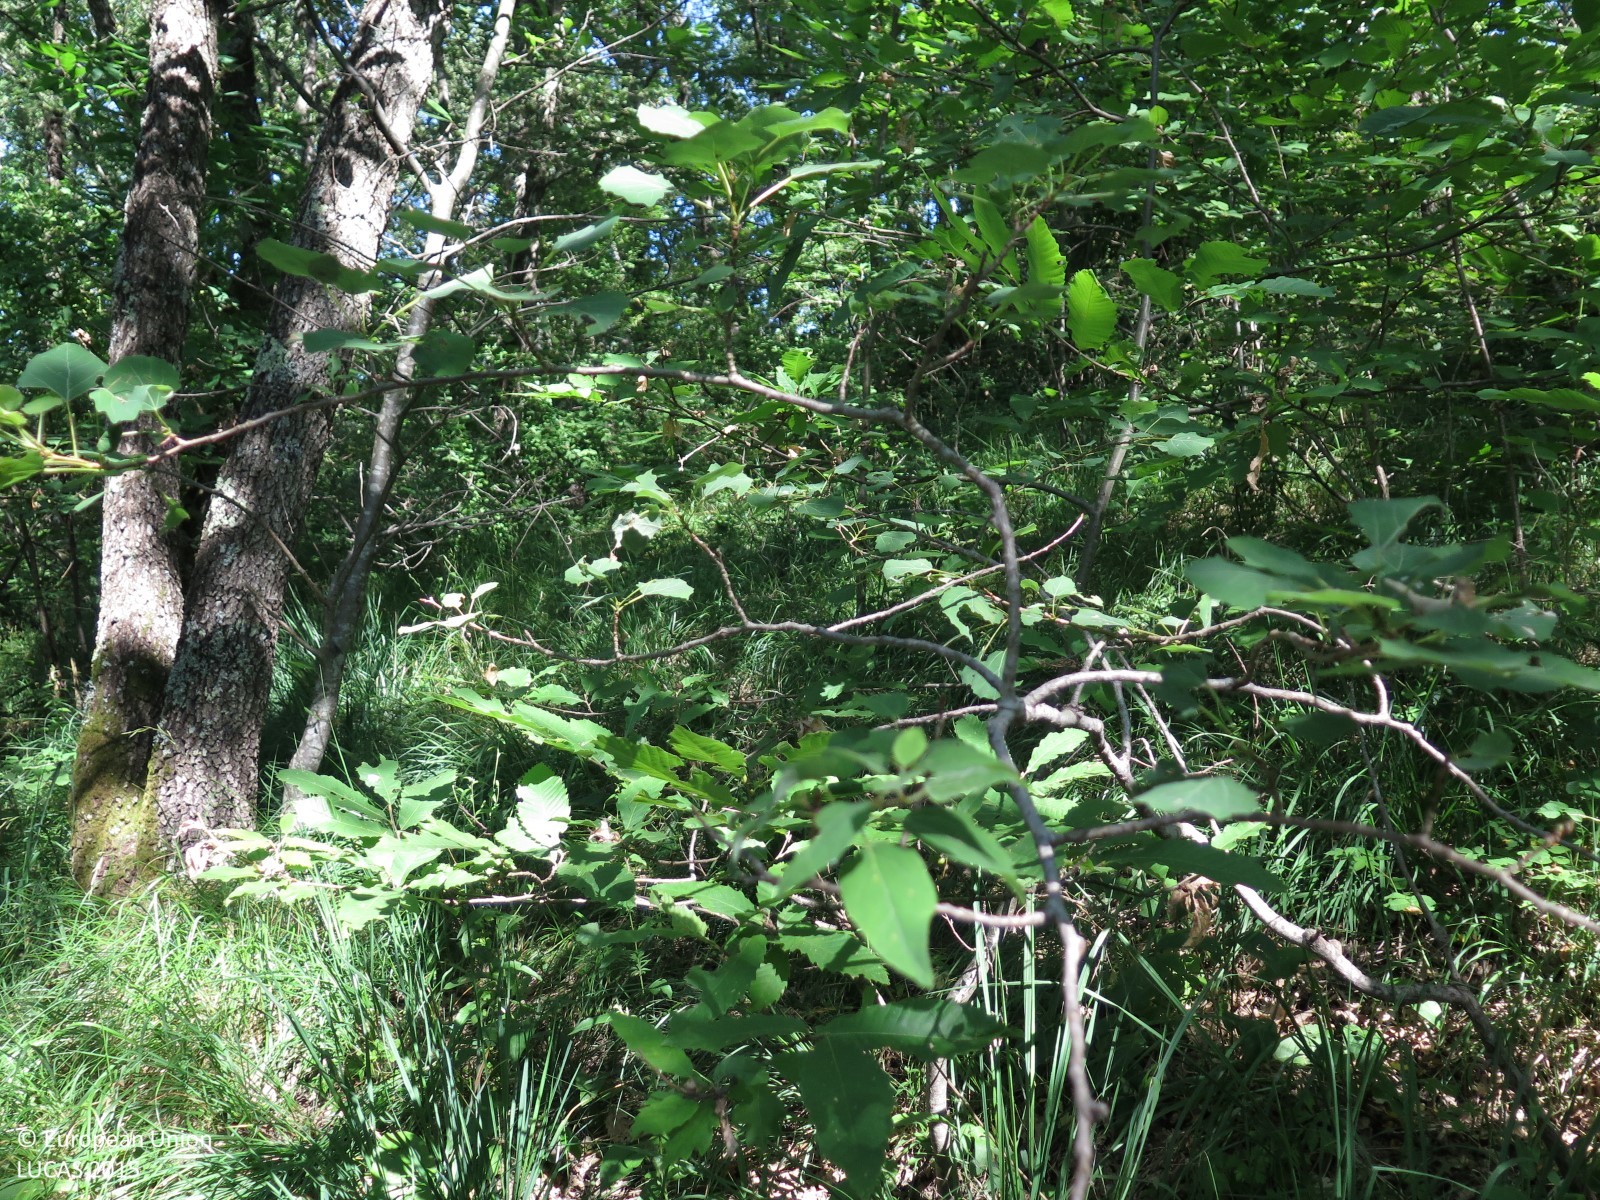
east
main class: Woodland
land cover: Broadleaved woodland
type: mesophytic deciduous forest
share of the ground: > 75 %
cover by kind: broadleaved forest trees 95 %, herbaceous plants 5 %
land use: Semi-natural and natural areas not in use
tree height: > 5 m
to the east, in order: Broadleaved woodland; Shrubland without tree cover; Electric lines; Shrubland without tree cover; Grassland with sparse tree/shrub cover; Tracks; Broadleaved woodland; Grass margins; Paved roads, cycling and walking lanes; Tracks; Abandoned hedges; Temporary grasslands
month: July
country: HR
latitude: 45.2707
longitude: 13.8824
